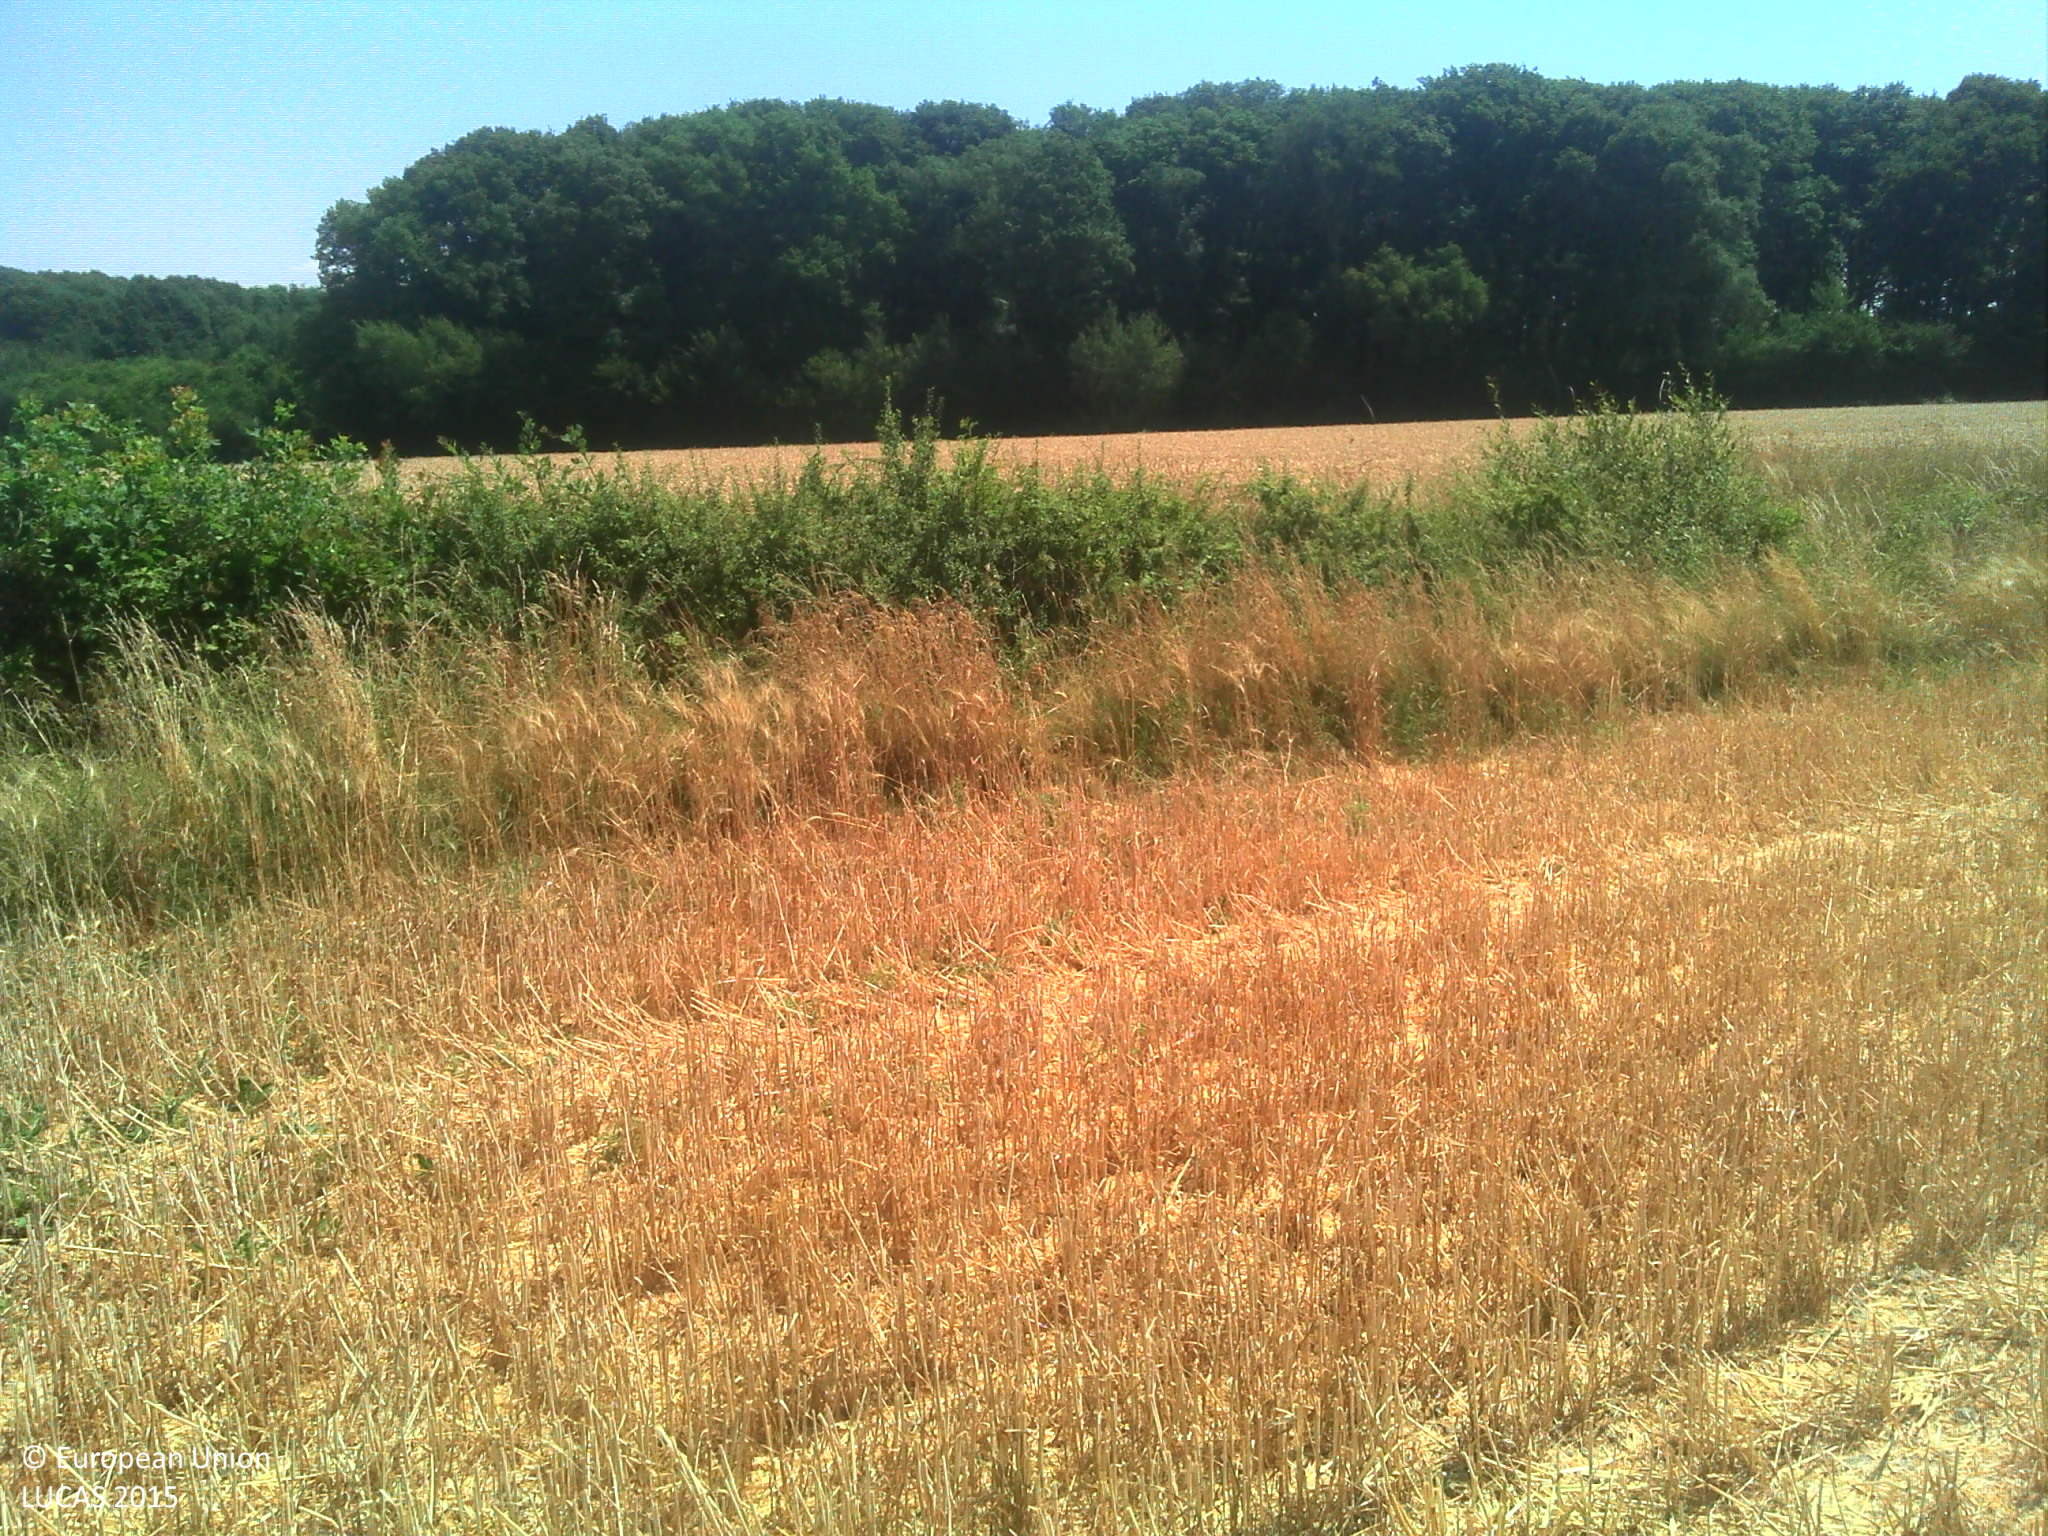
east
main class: Cropland
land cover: Durum wheat
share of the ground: > 75 %
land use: Agriculture (excluding fallow land and kitchen gardens)
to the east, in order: Durum wheat; Managed hedges; Tracks; Grass margins; Common wheat; Grass margins; Broadleaved woodland
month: July
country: FR
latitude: 48.0790
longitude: 0.8653
